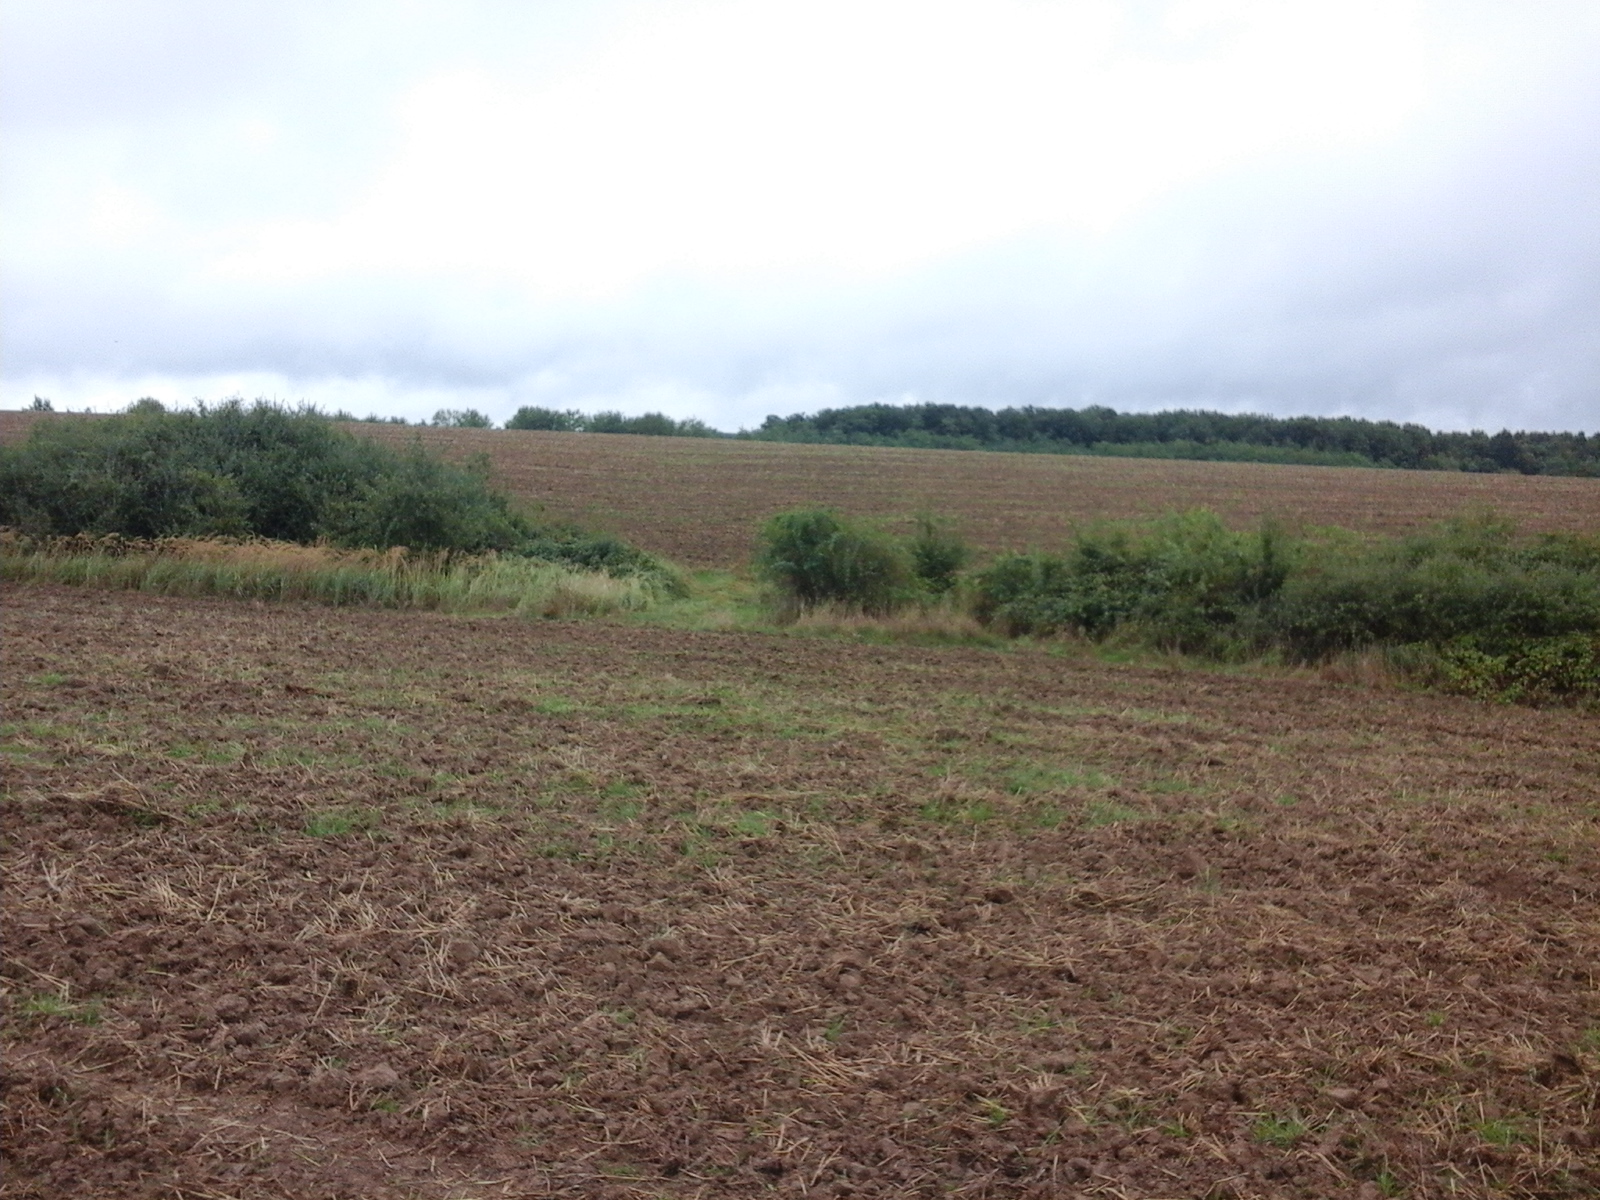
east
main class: Cropland
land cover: Common wheat
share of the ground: < 10 %
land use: Agriculture (excluding fallow land and kitchen gardens)
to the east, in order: Common wheat; Abandoned hedges; Common wheat
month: September
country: RO
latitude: 46.8060
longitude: 21.9568
